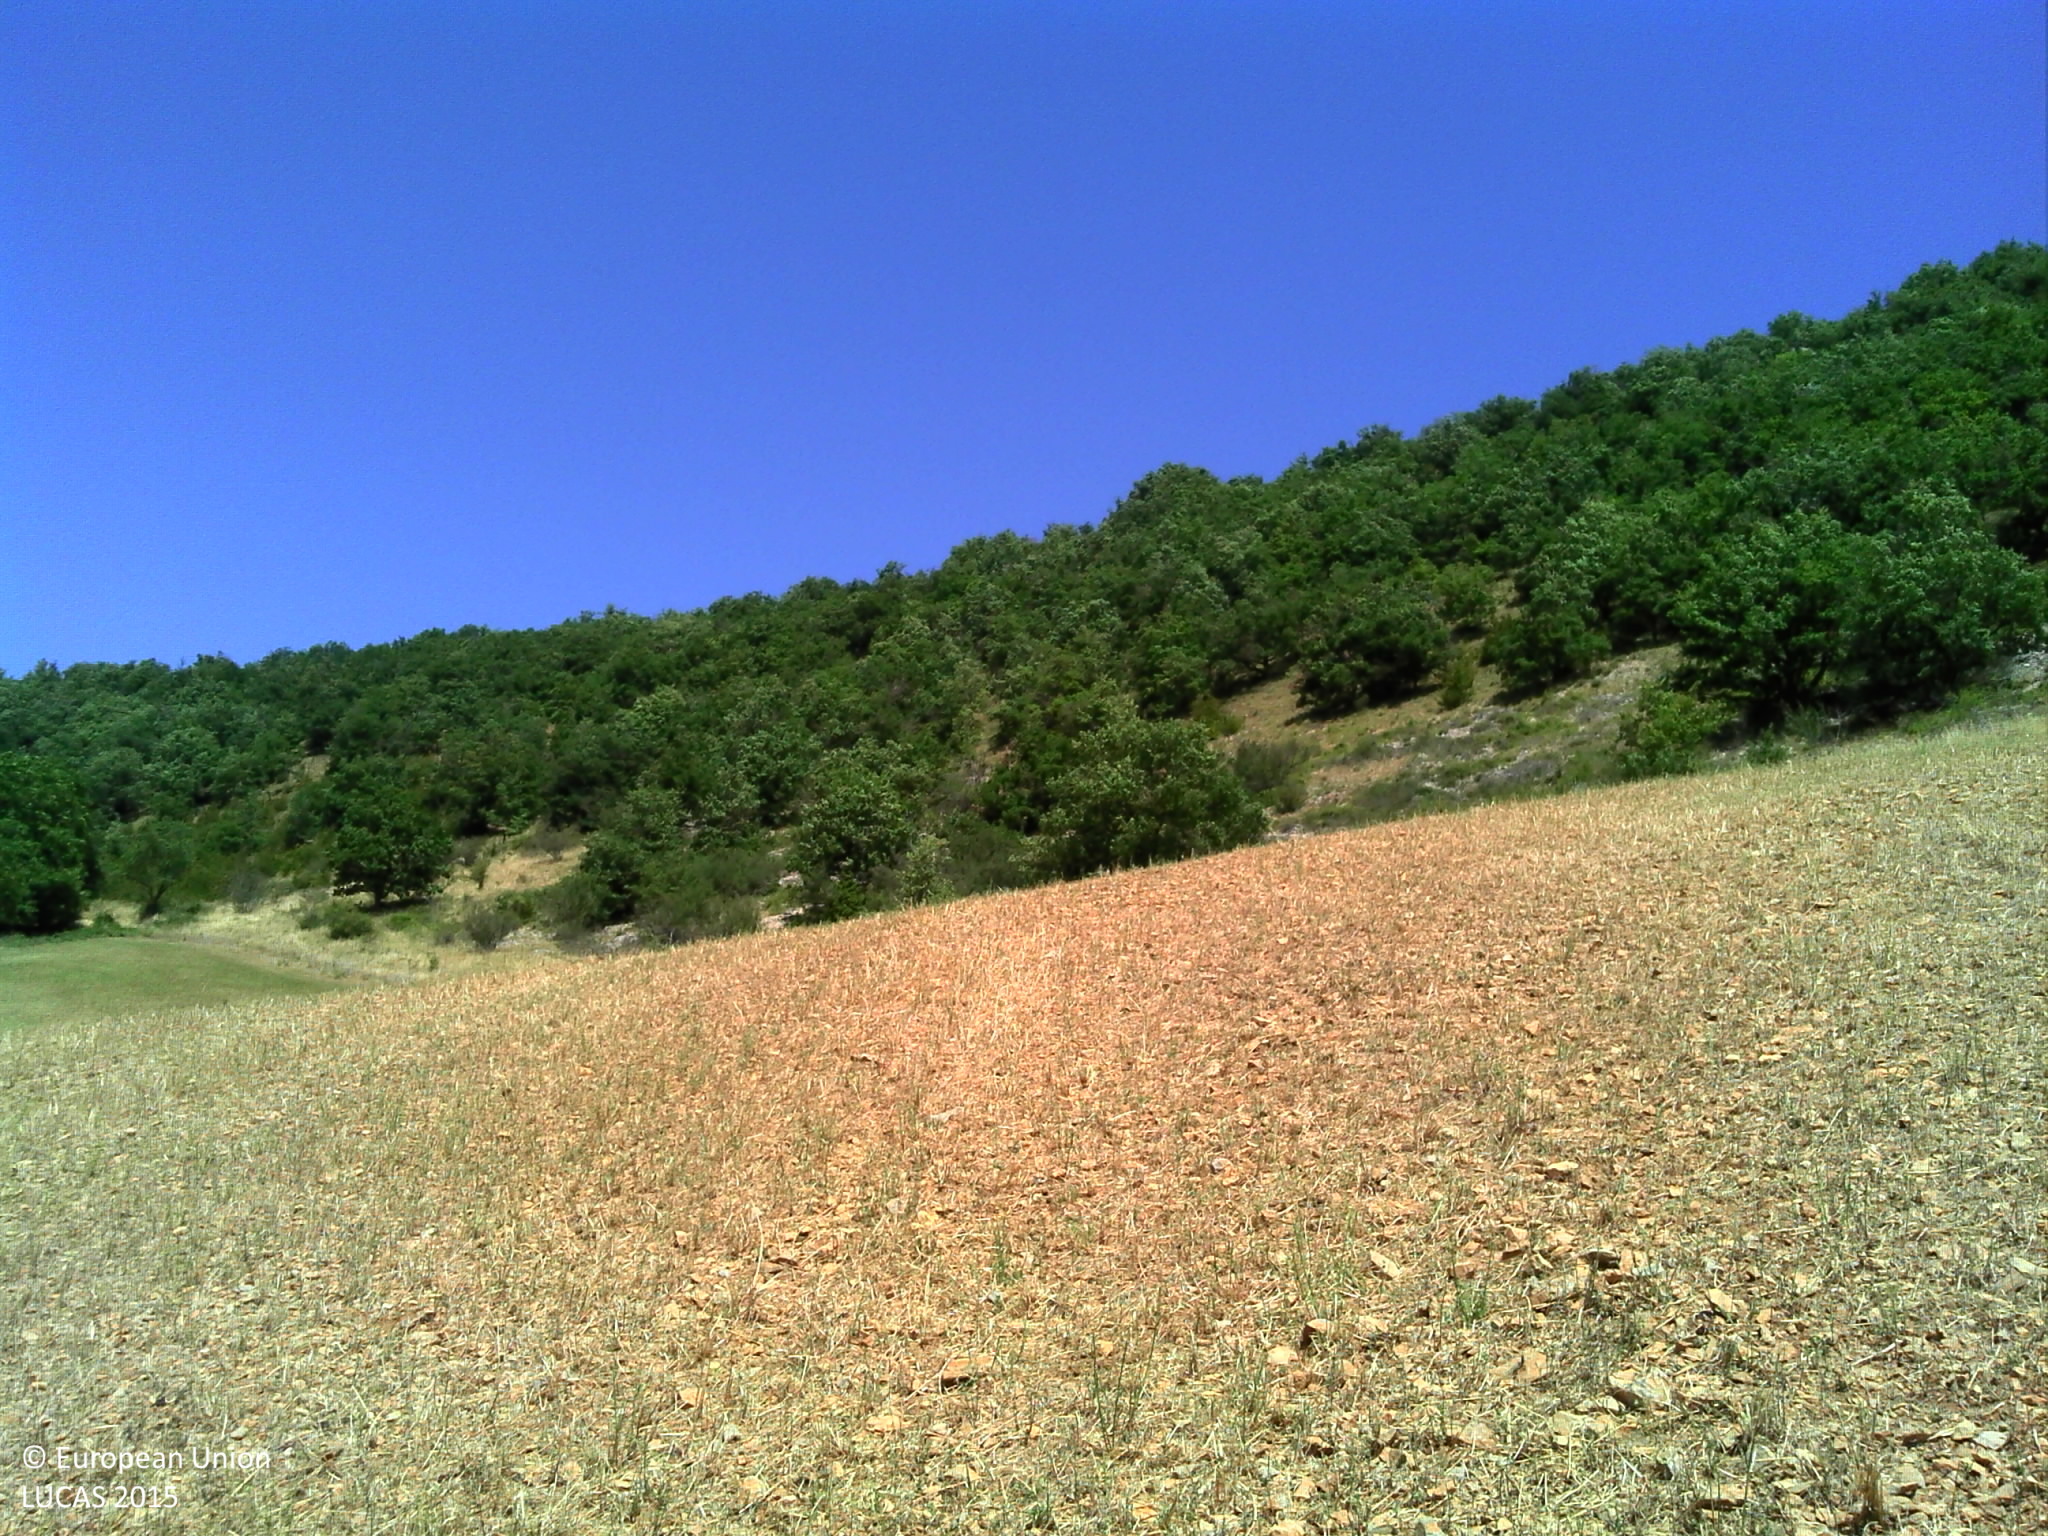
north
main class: Cropland
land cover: Temporary grasslands
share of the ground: 25 - 50 %
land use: Agriculture (excluding fallow land and kitchen gardens)
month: July
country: FR
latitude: 44.1367
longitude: 3.0684
